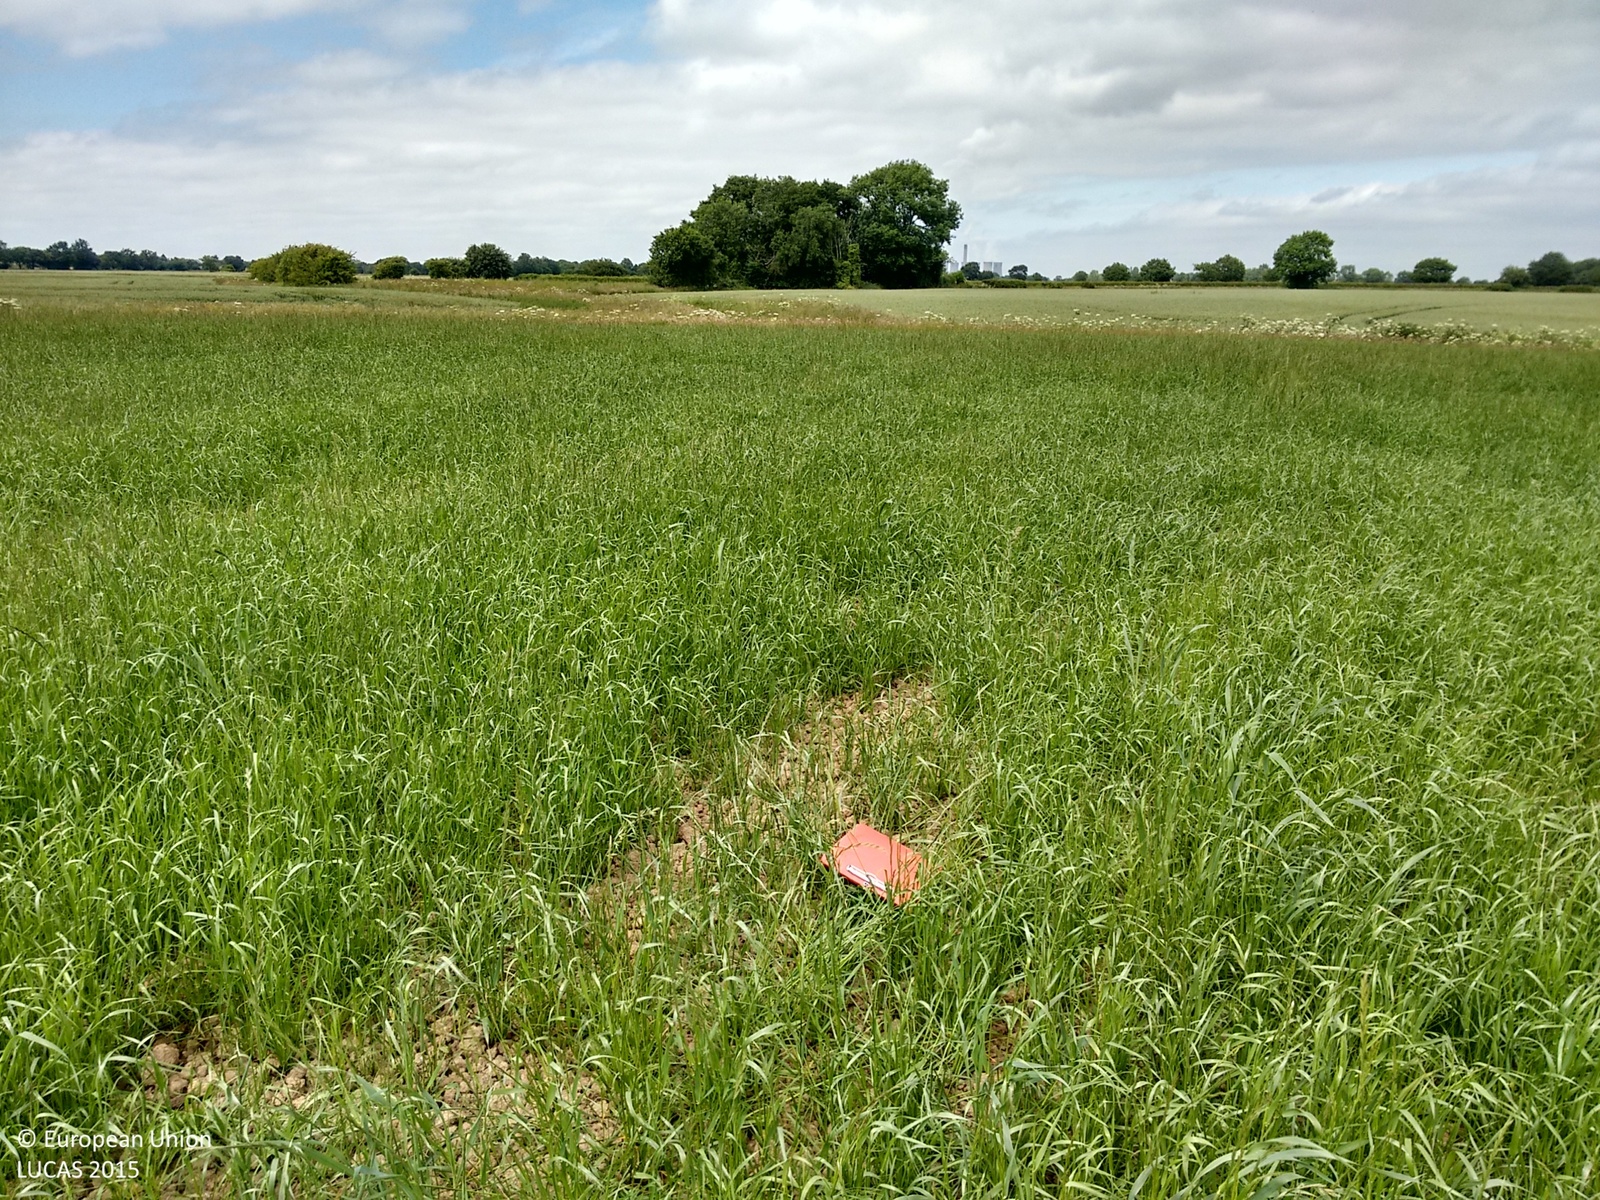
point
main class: Cropland
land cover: Barley
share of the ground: > 75 %
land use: Agriculture (excluding fallow land and kitchen gardens)
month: June
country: GB
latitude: 53.6493
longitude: -1.1342
